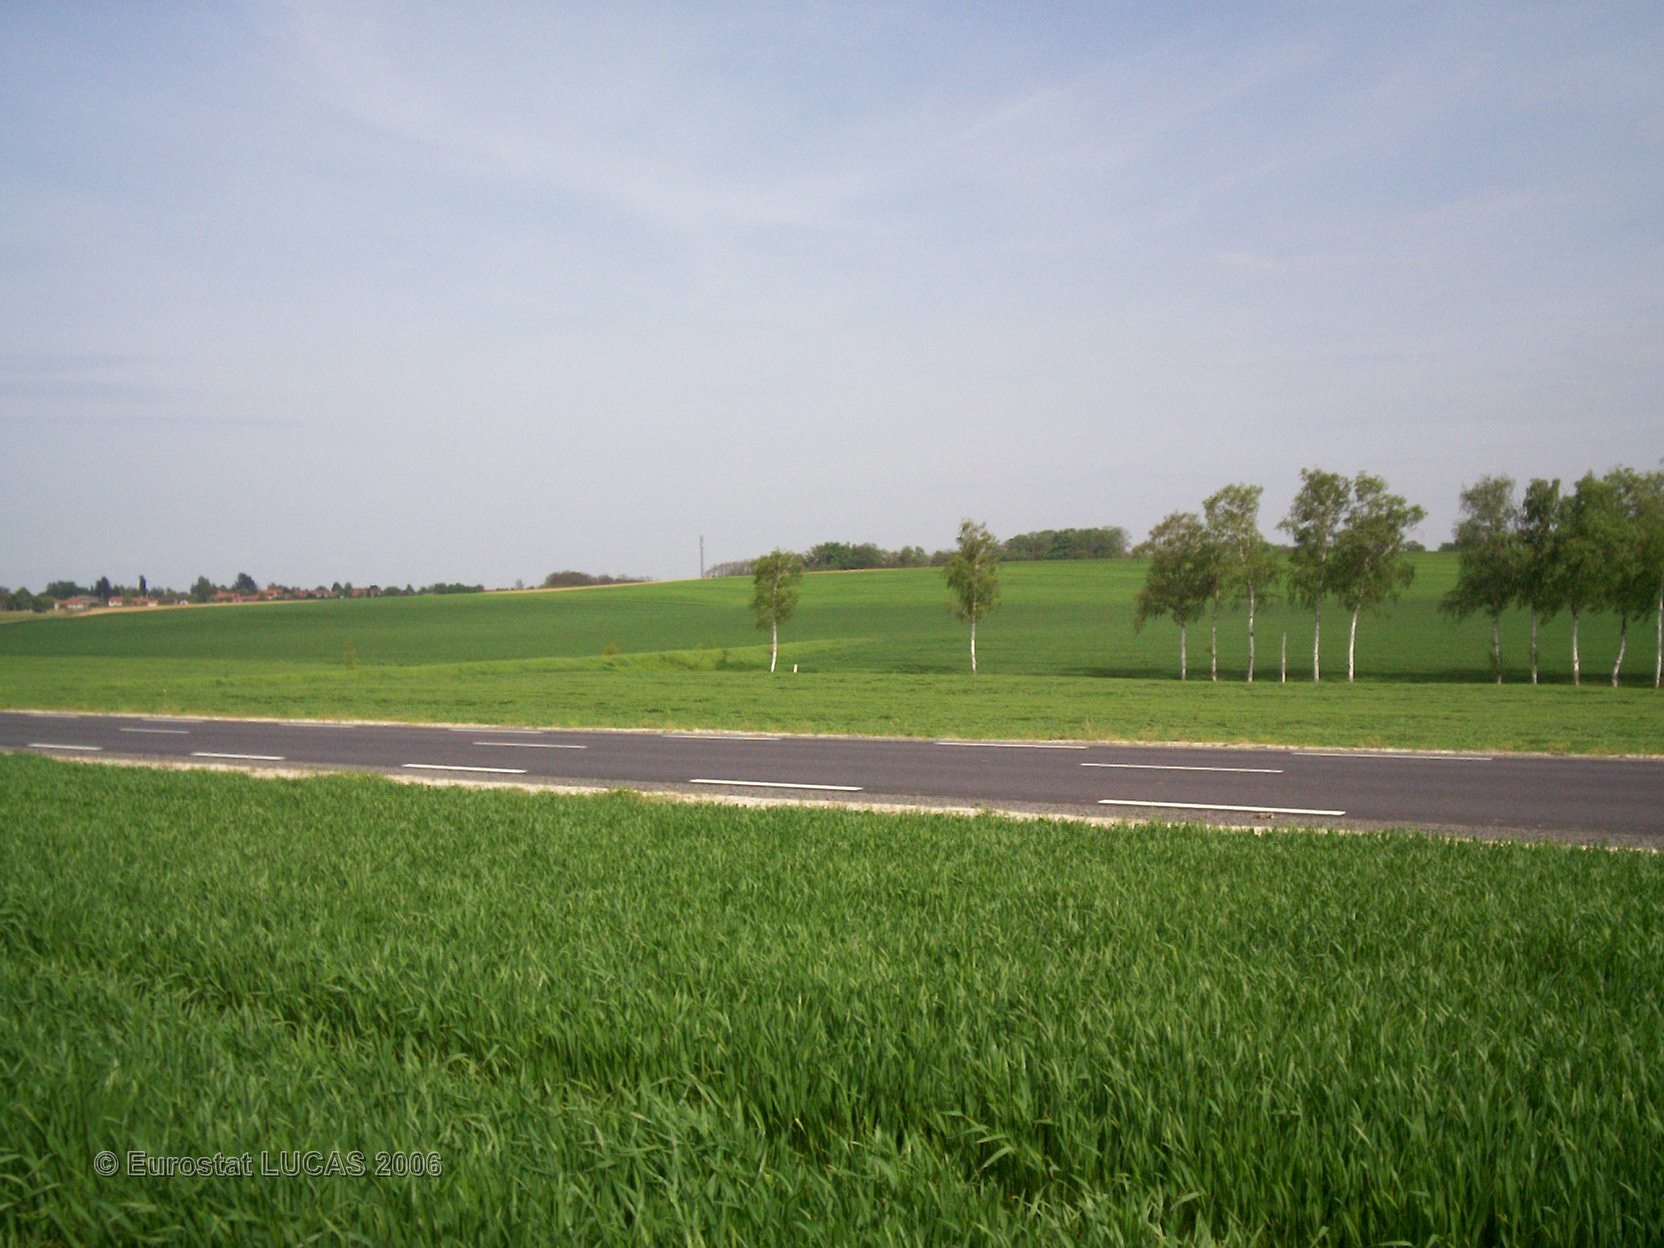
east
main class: Cropland
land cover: Common wheat
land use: Agriculture (excluding fallow land and kitchen gardens)
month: May
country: FR
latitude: 45.9901
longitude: 4.8002
